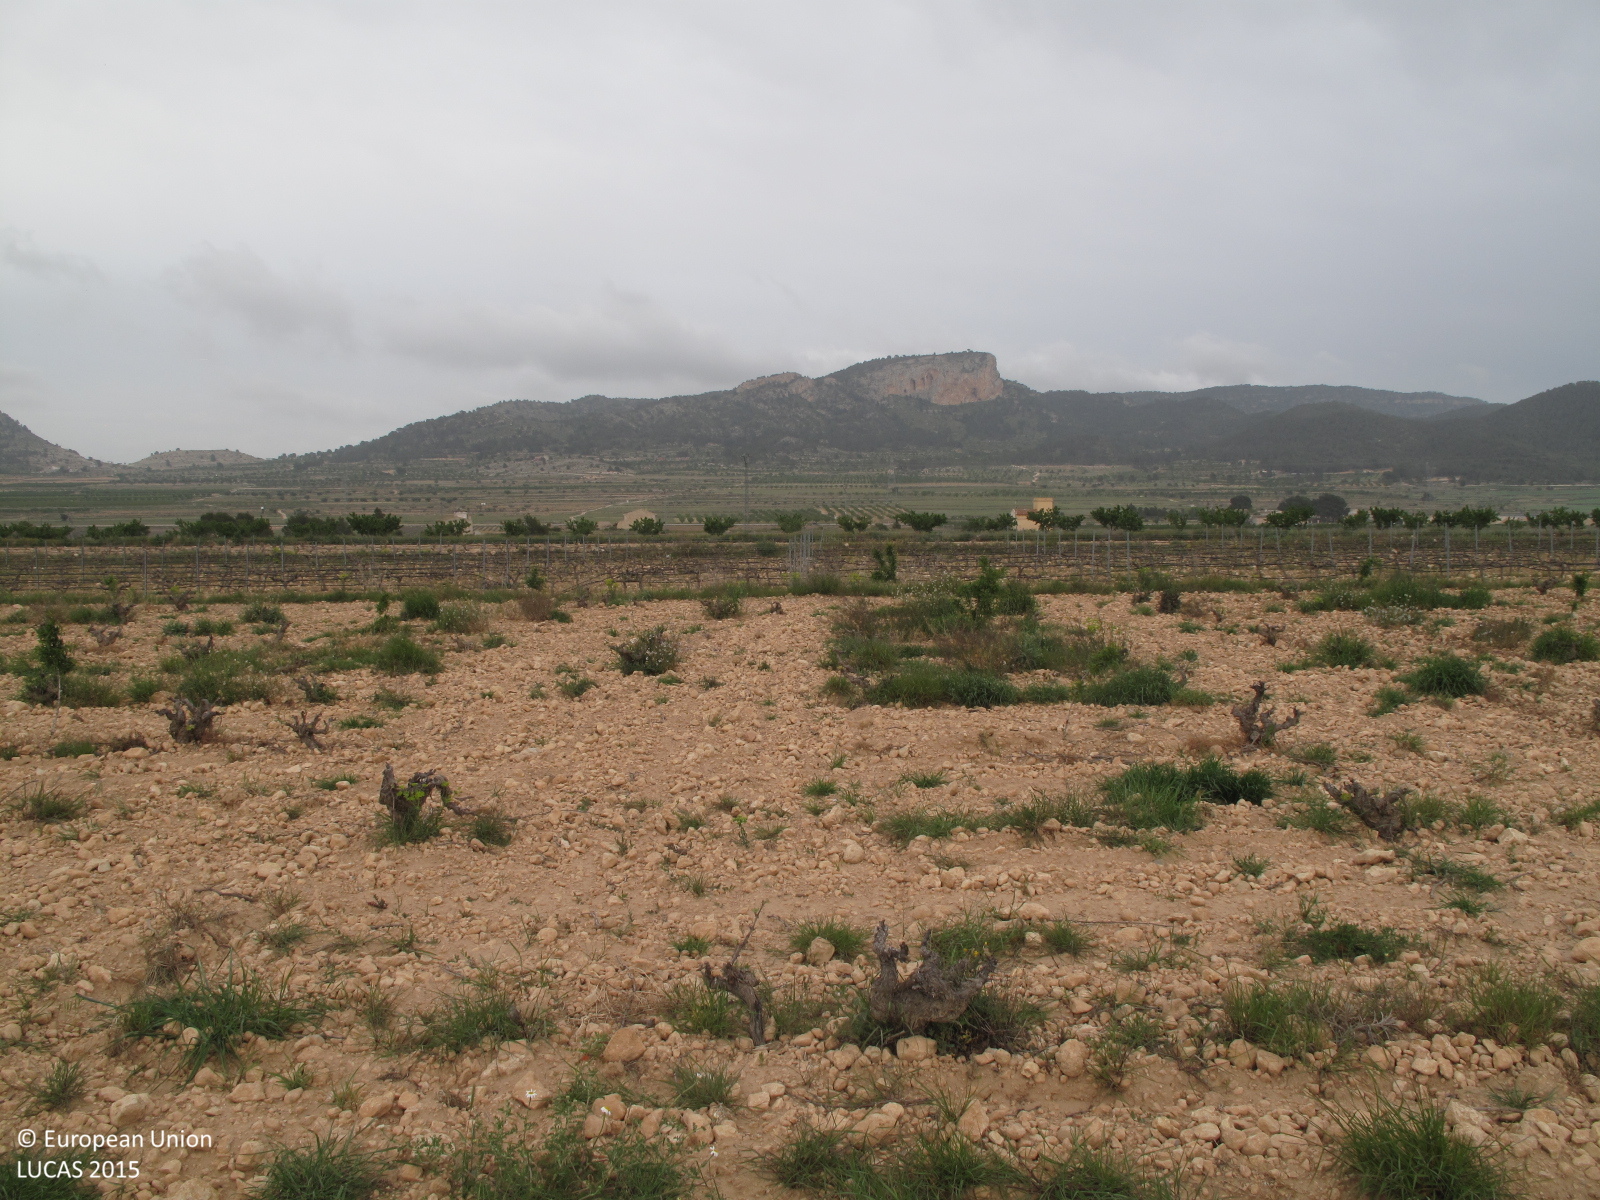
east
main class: Cropland
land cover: Vineyards
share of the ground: < 10 %
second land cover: Nuts trees
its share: < 10 %
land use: Agriculture (excluding fallow land and kitchen gardens)
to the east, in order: Vineyards; Nuts trees; Grass margins; Vineyards; Grass margins; Vineyards; Grass margins; Vineyards; Grass margins; Nuts trees; Grassland with sparse tree/shrub cover; Electric lines; Grassland with sparse tree/shrub cover; Dry stone walls; Grassland with sparse tree/shrub cover
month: April
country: ES
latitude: 38.4139
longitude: -0.9254
